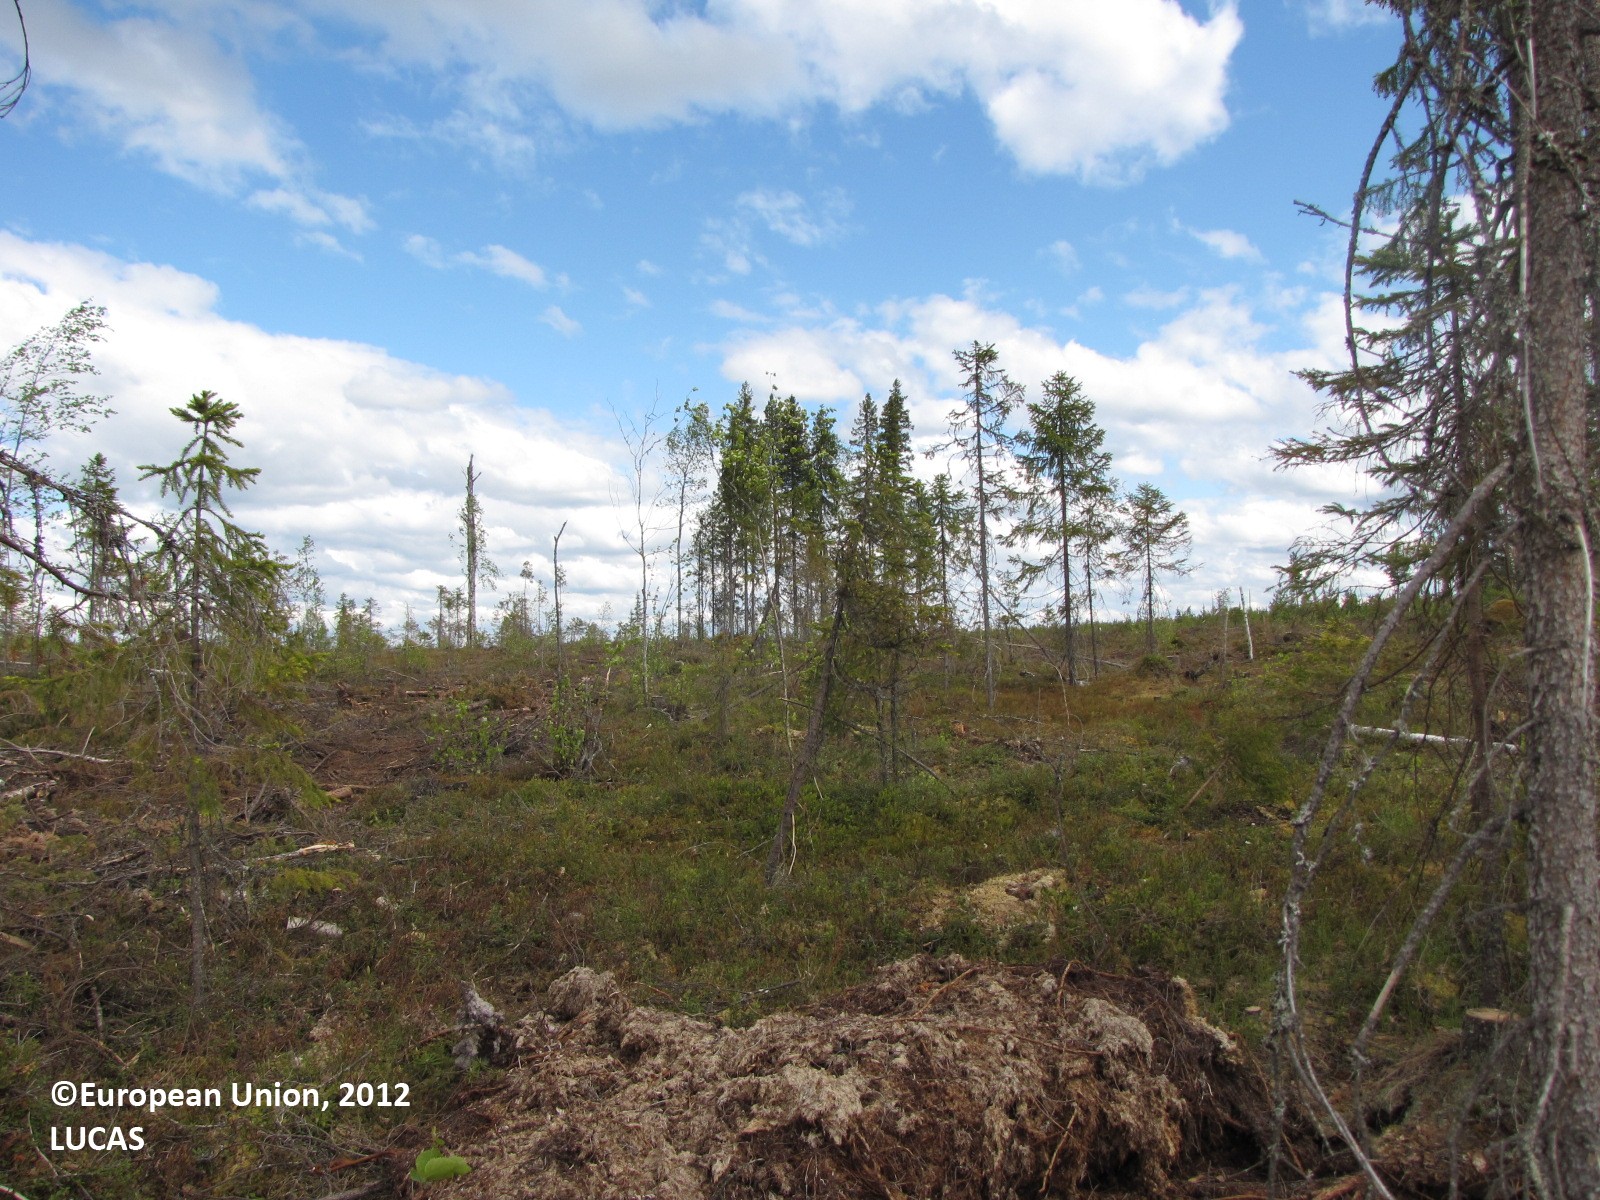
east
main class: Woodland
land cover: Other mixed woodland
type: boreal forest
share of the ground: 10 - 25 %
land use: Forestry
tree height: > 5 m
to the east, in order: Other mixed woodland; Other bare soil
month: June
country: FI
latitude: 66.1069
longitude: 25.1294
